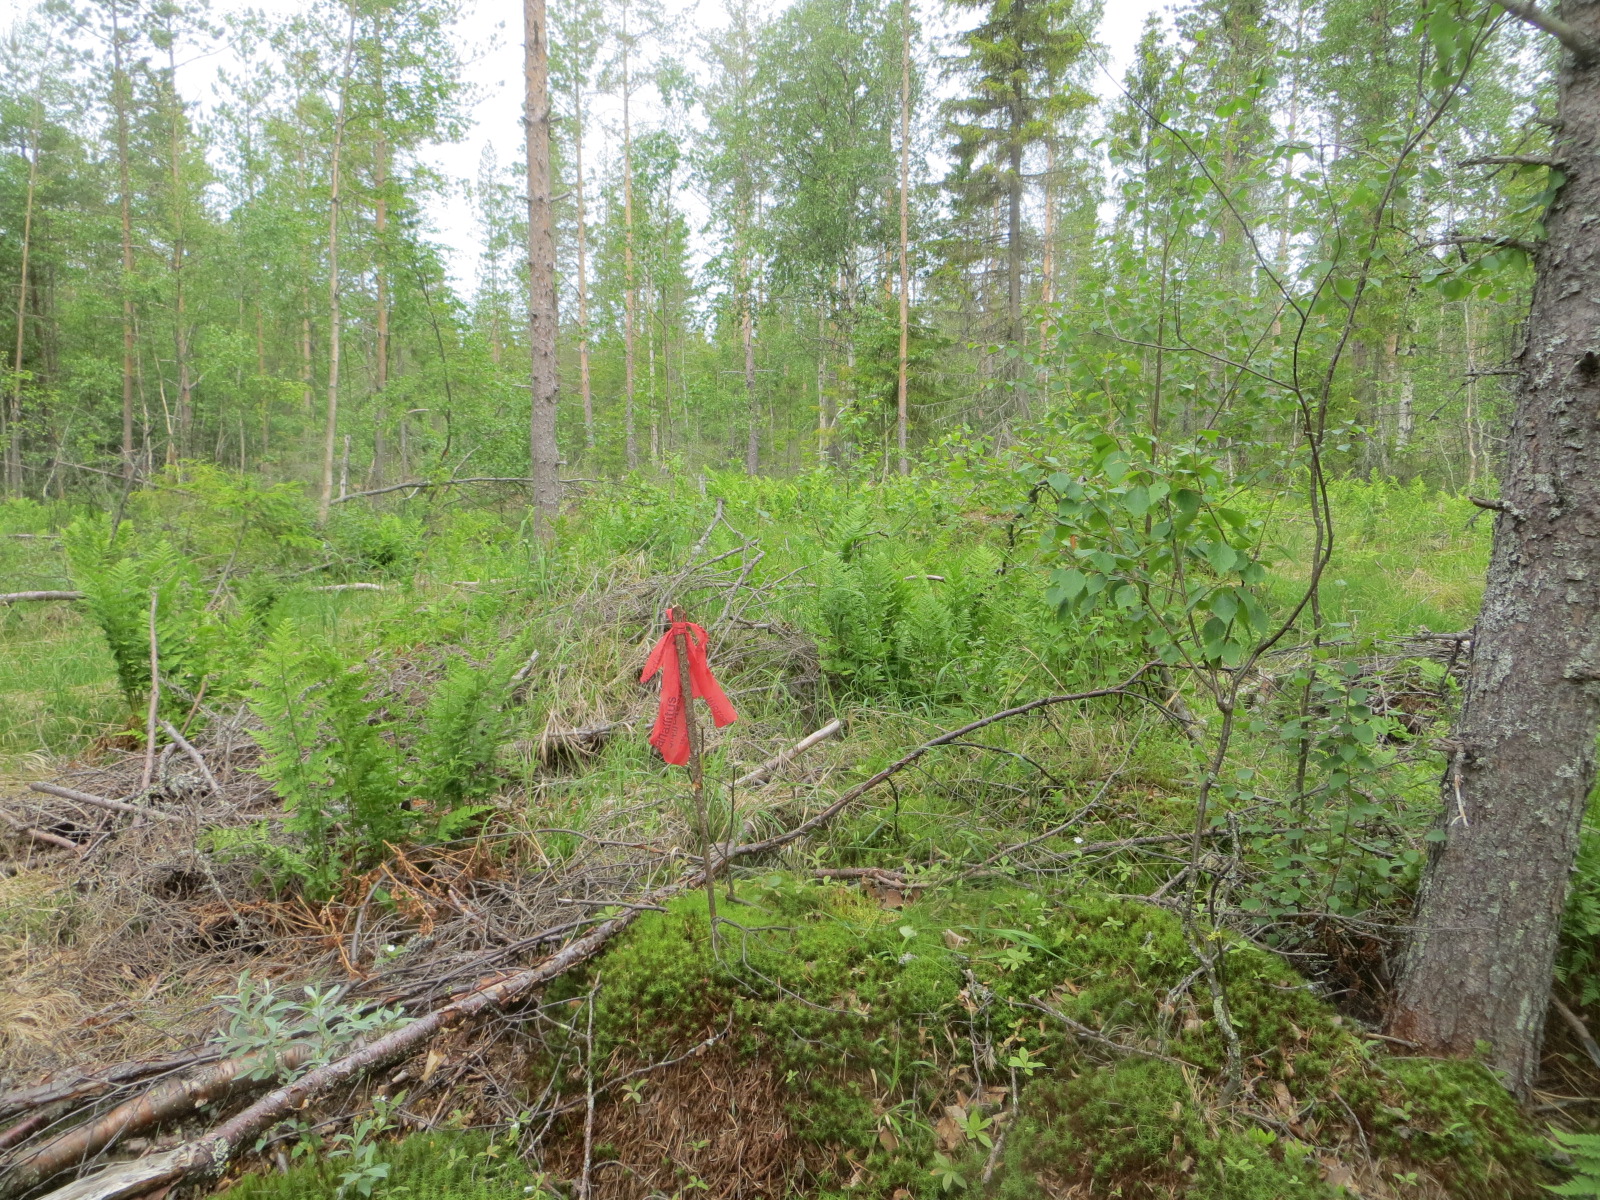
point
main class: Woodland
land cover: Pine dominated mixed woodland
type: boreal forest
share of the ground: 50 - 75 %
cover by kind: coniferous forest trees 40 %, shrubs 40 %, broadleaved forest trees 20 %
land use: Forestry
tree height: > 5 m
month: July
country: FI
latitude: 65.3820
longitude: 26.1215
